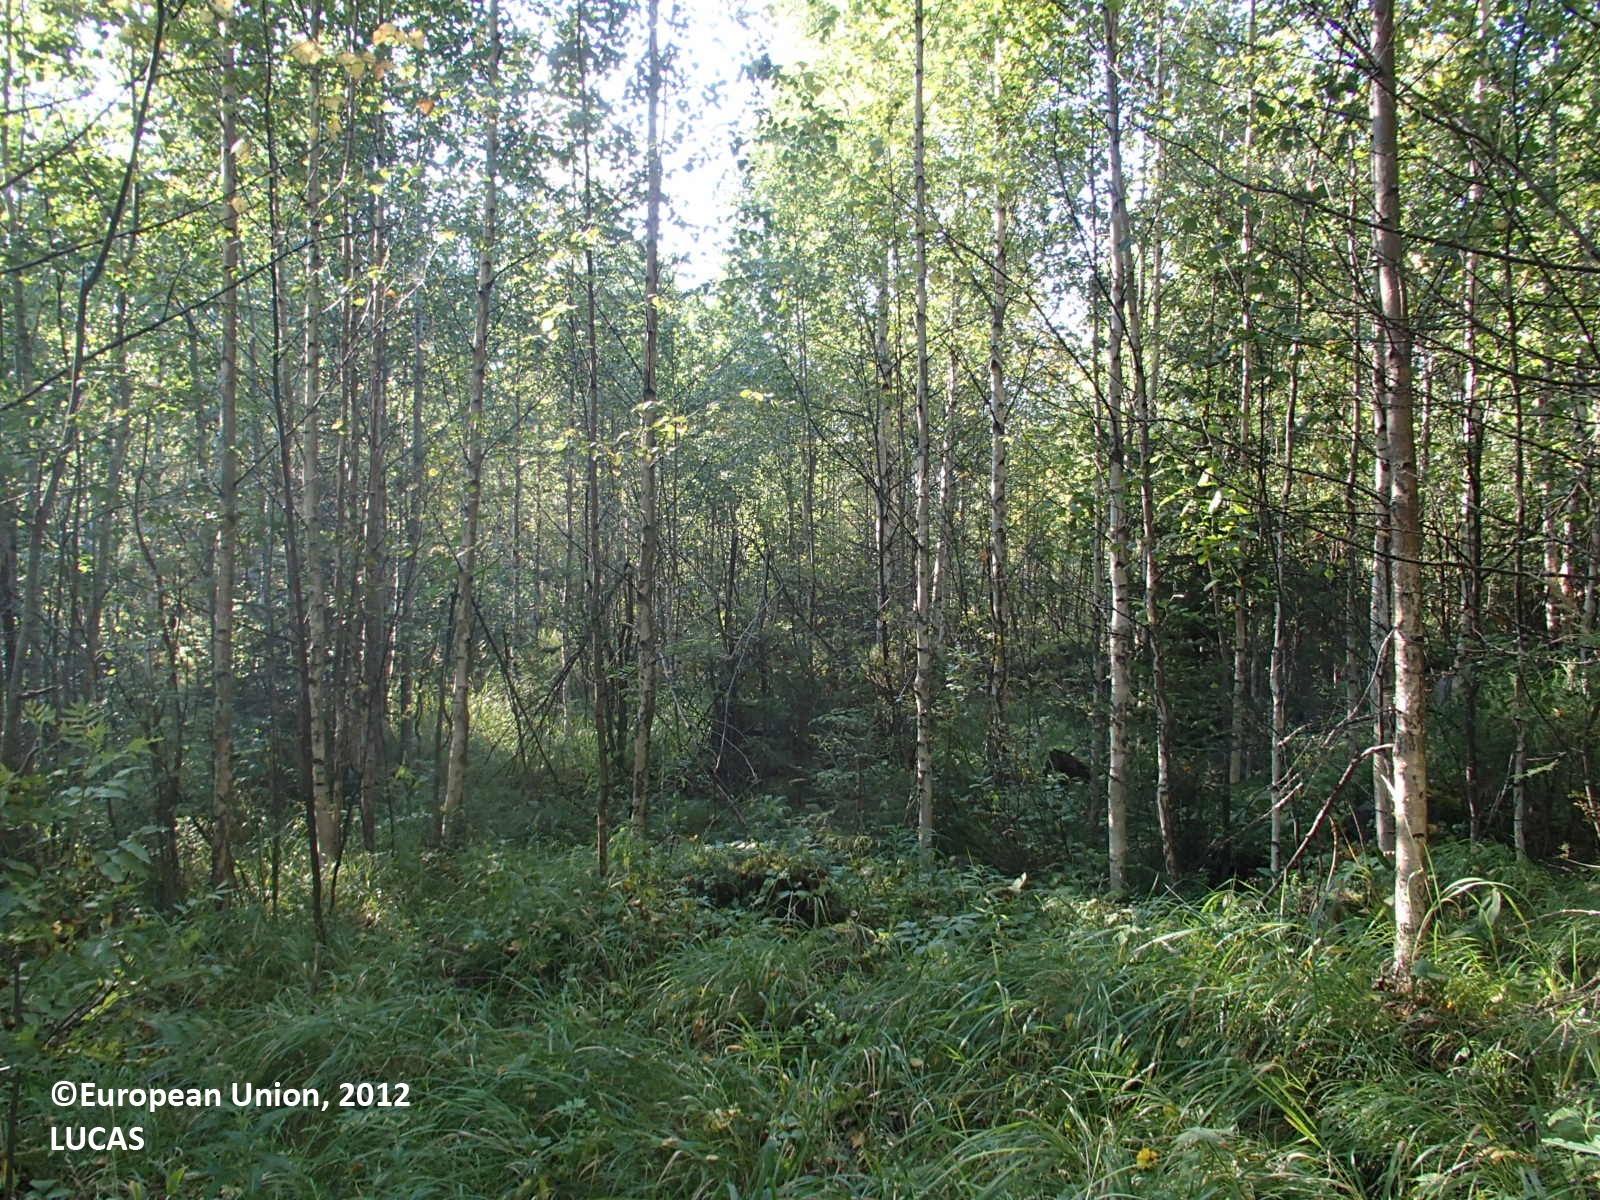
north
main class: Woodland
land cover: Broadleaved woodland
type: non-riverine alder, birch or aspen forest
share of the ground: > 75 %
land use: Forestry
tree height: > 5 m
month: August
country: FI
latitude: 63.5264
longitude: 27.9647
